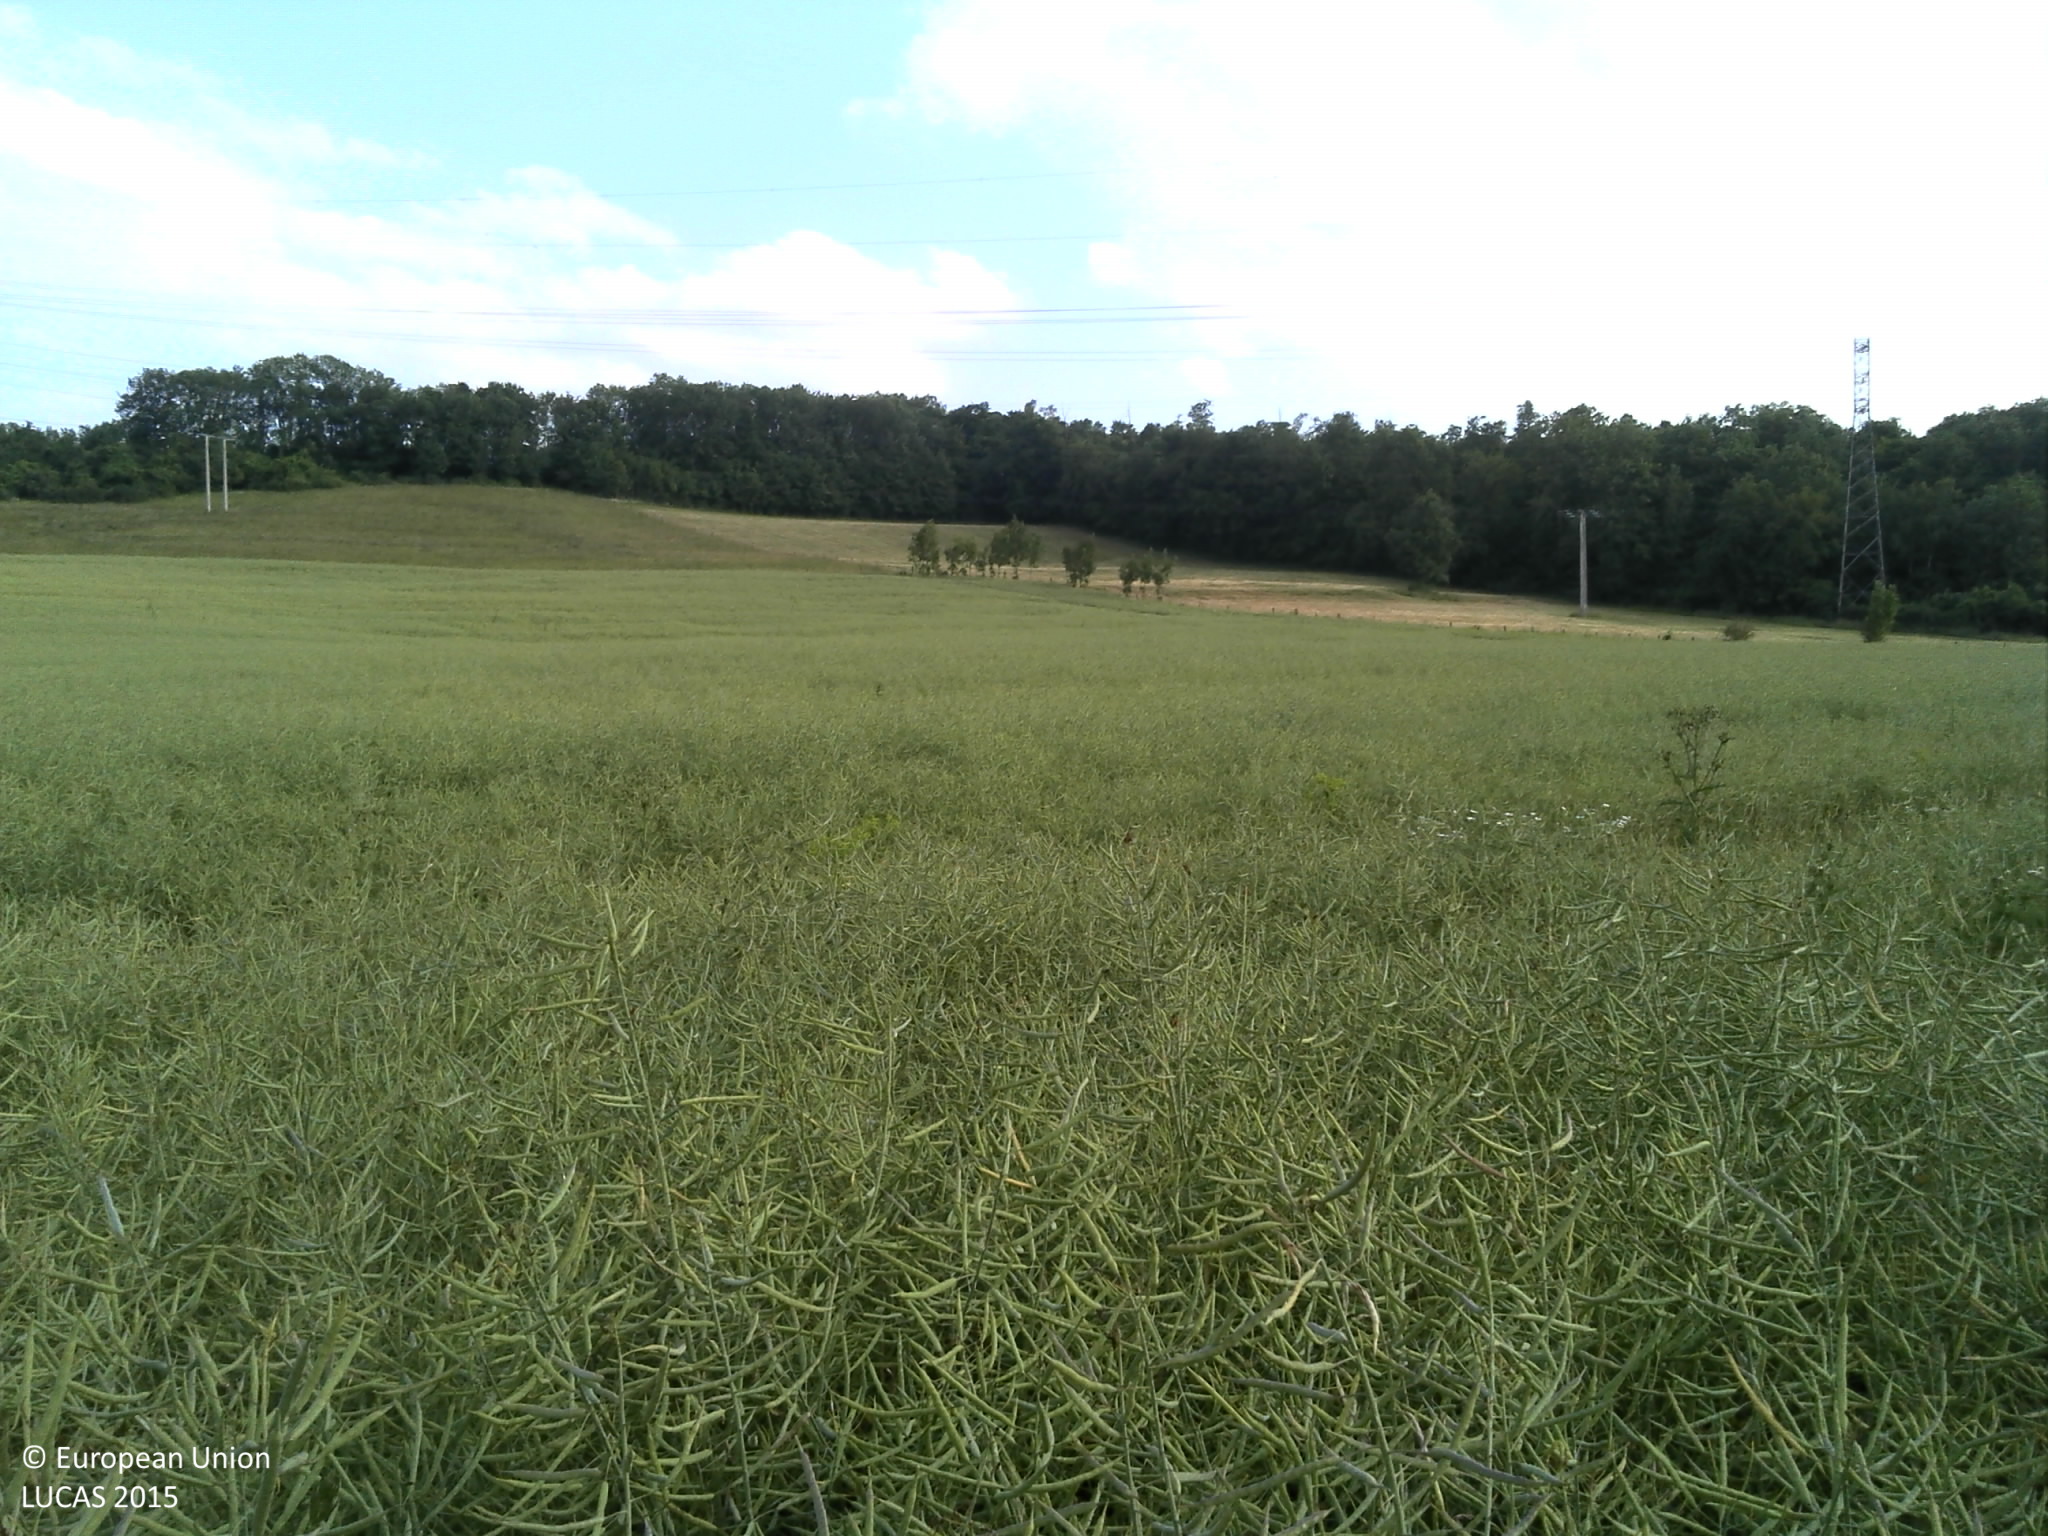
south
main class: Cropland
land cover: Rape and turnip rape
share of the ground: > 75 %
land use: Agriculture (excluding fallow land and kitchen gardens)
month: June
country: FR
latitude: 49.1497
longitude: 6.2295
